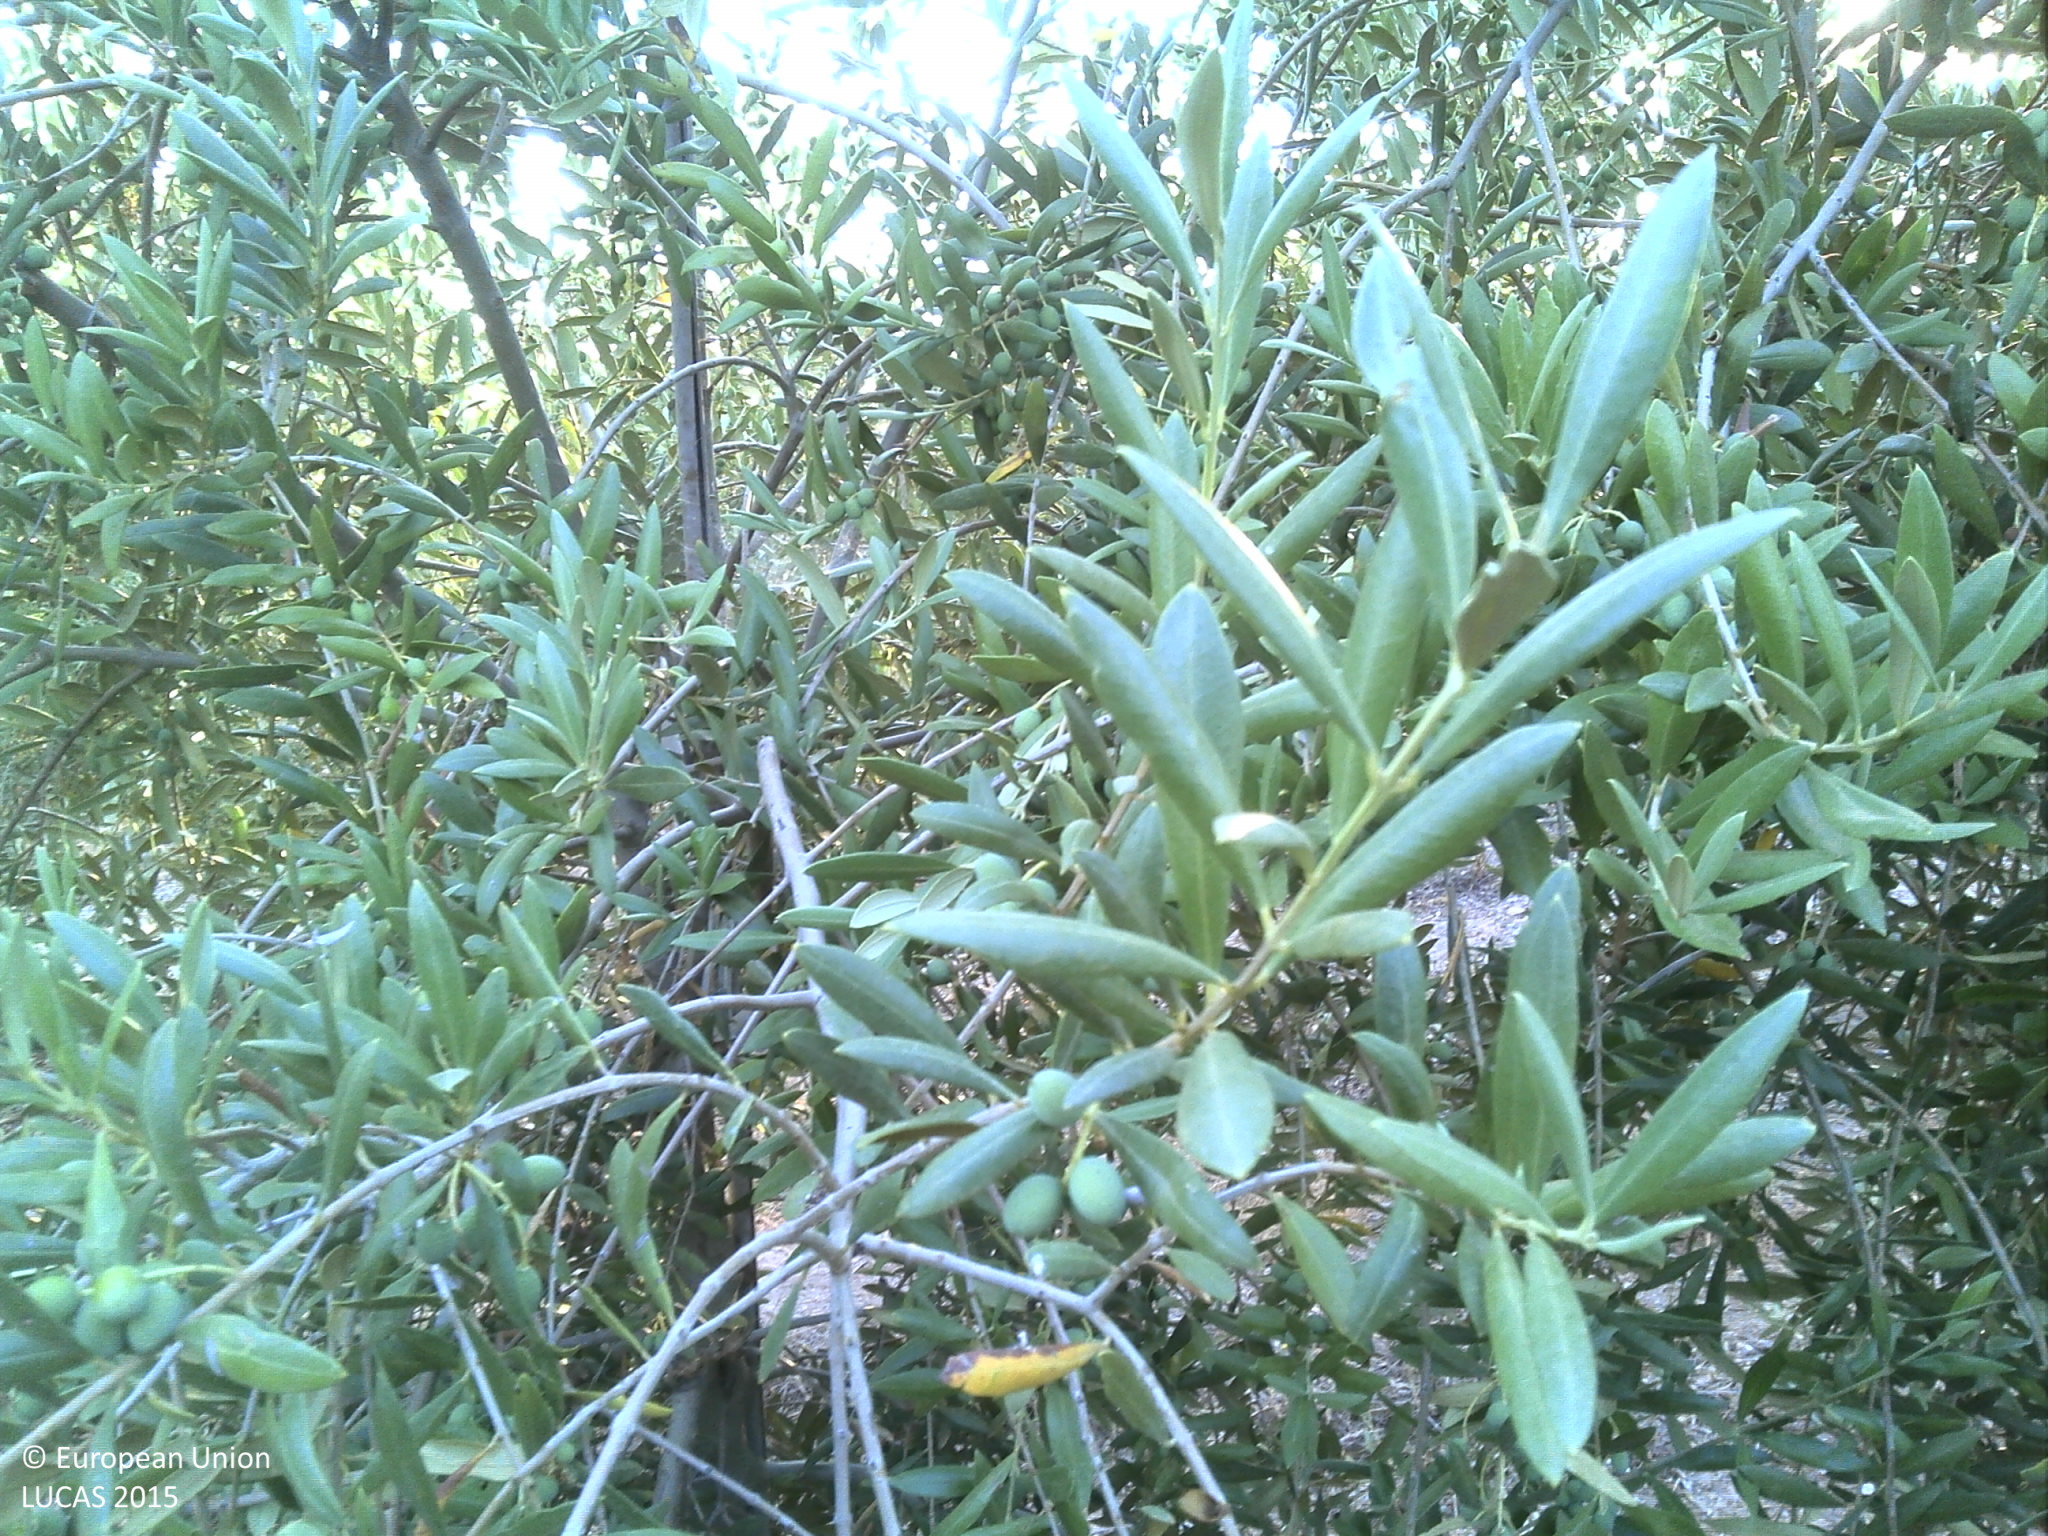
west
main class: Cropland
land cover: Olive groves
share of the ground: 50 - 75 %
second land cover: Grassland without tree/shrub cover
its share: 10 - 25 %
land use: Agriculture (excluding fallow land and kitchen gardens)
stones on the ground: < 10 %
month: June
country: PT
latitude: 38.3162
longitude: -7.3727
